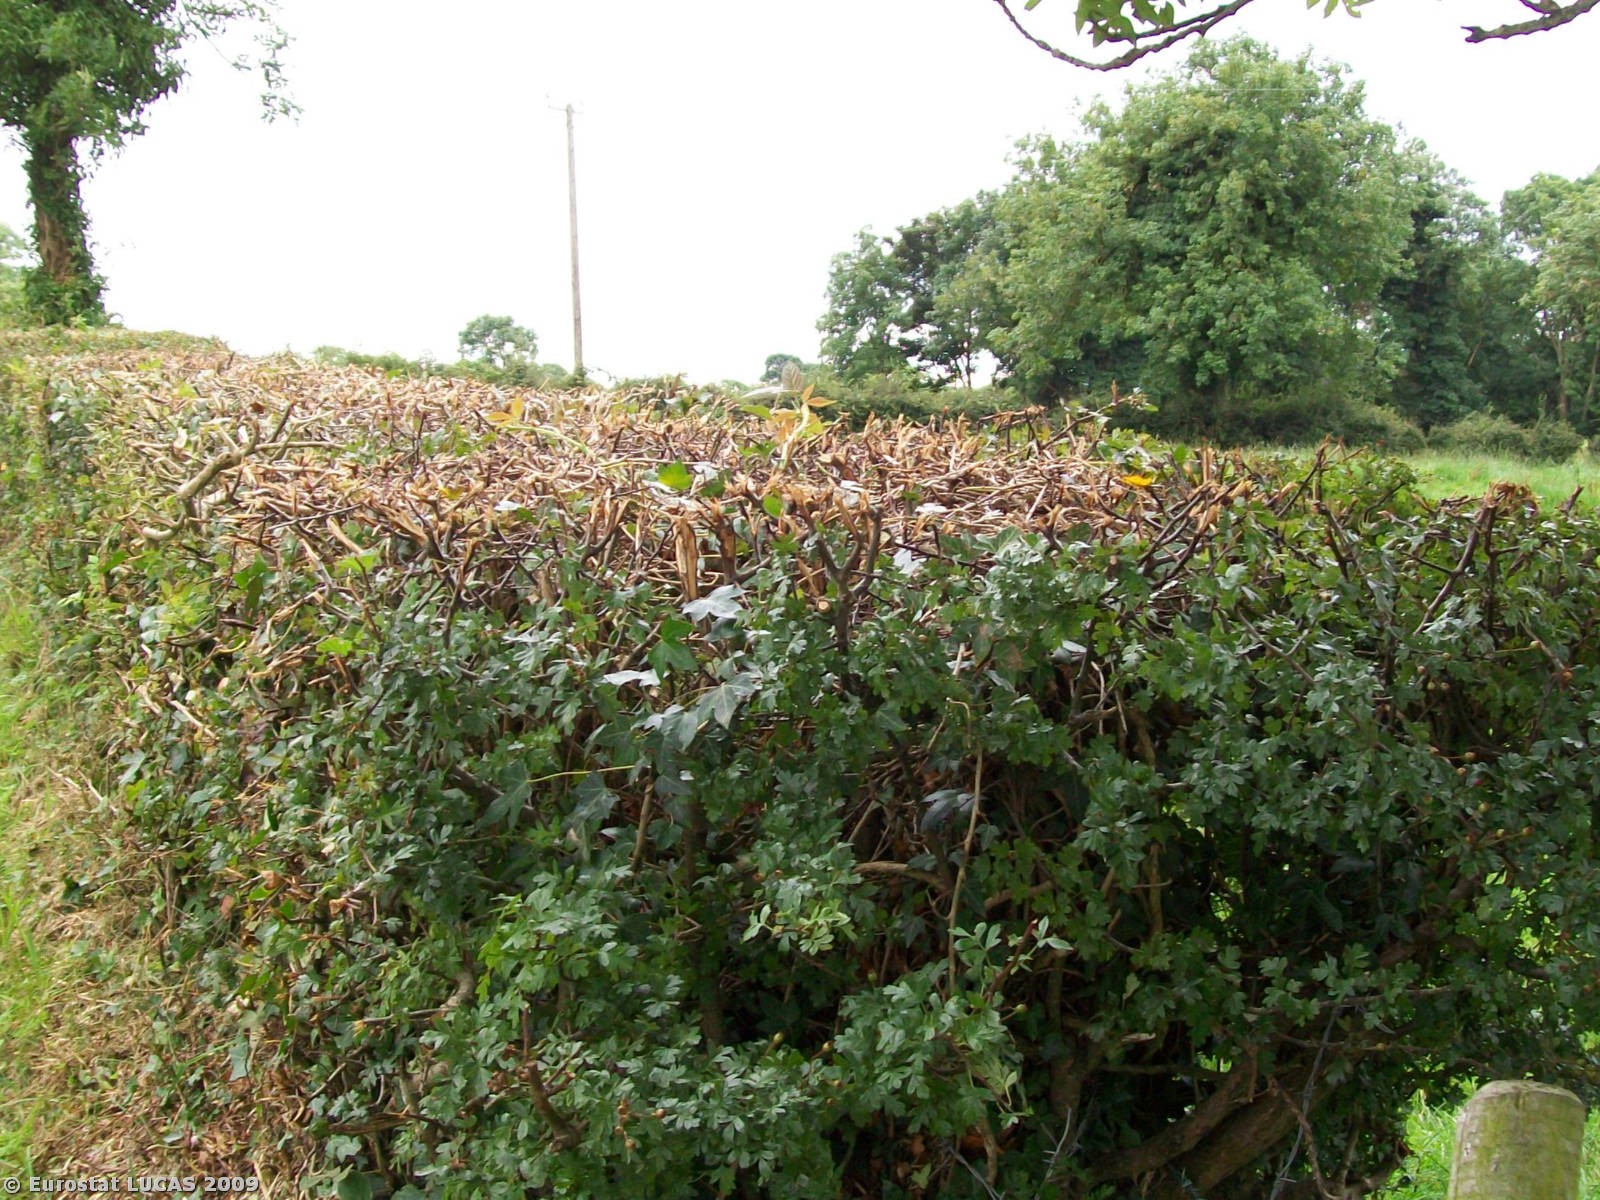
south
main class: Grassland
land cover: Grassland without tree/shrub cover
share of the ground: > 75 %
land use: Agriculture (excluding fallow land and kitchen gardens)
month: August
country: GB
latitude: 54.1364
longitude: -6.6129
